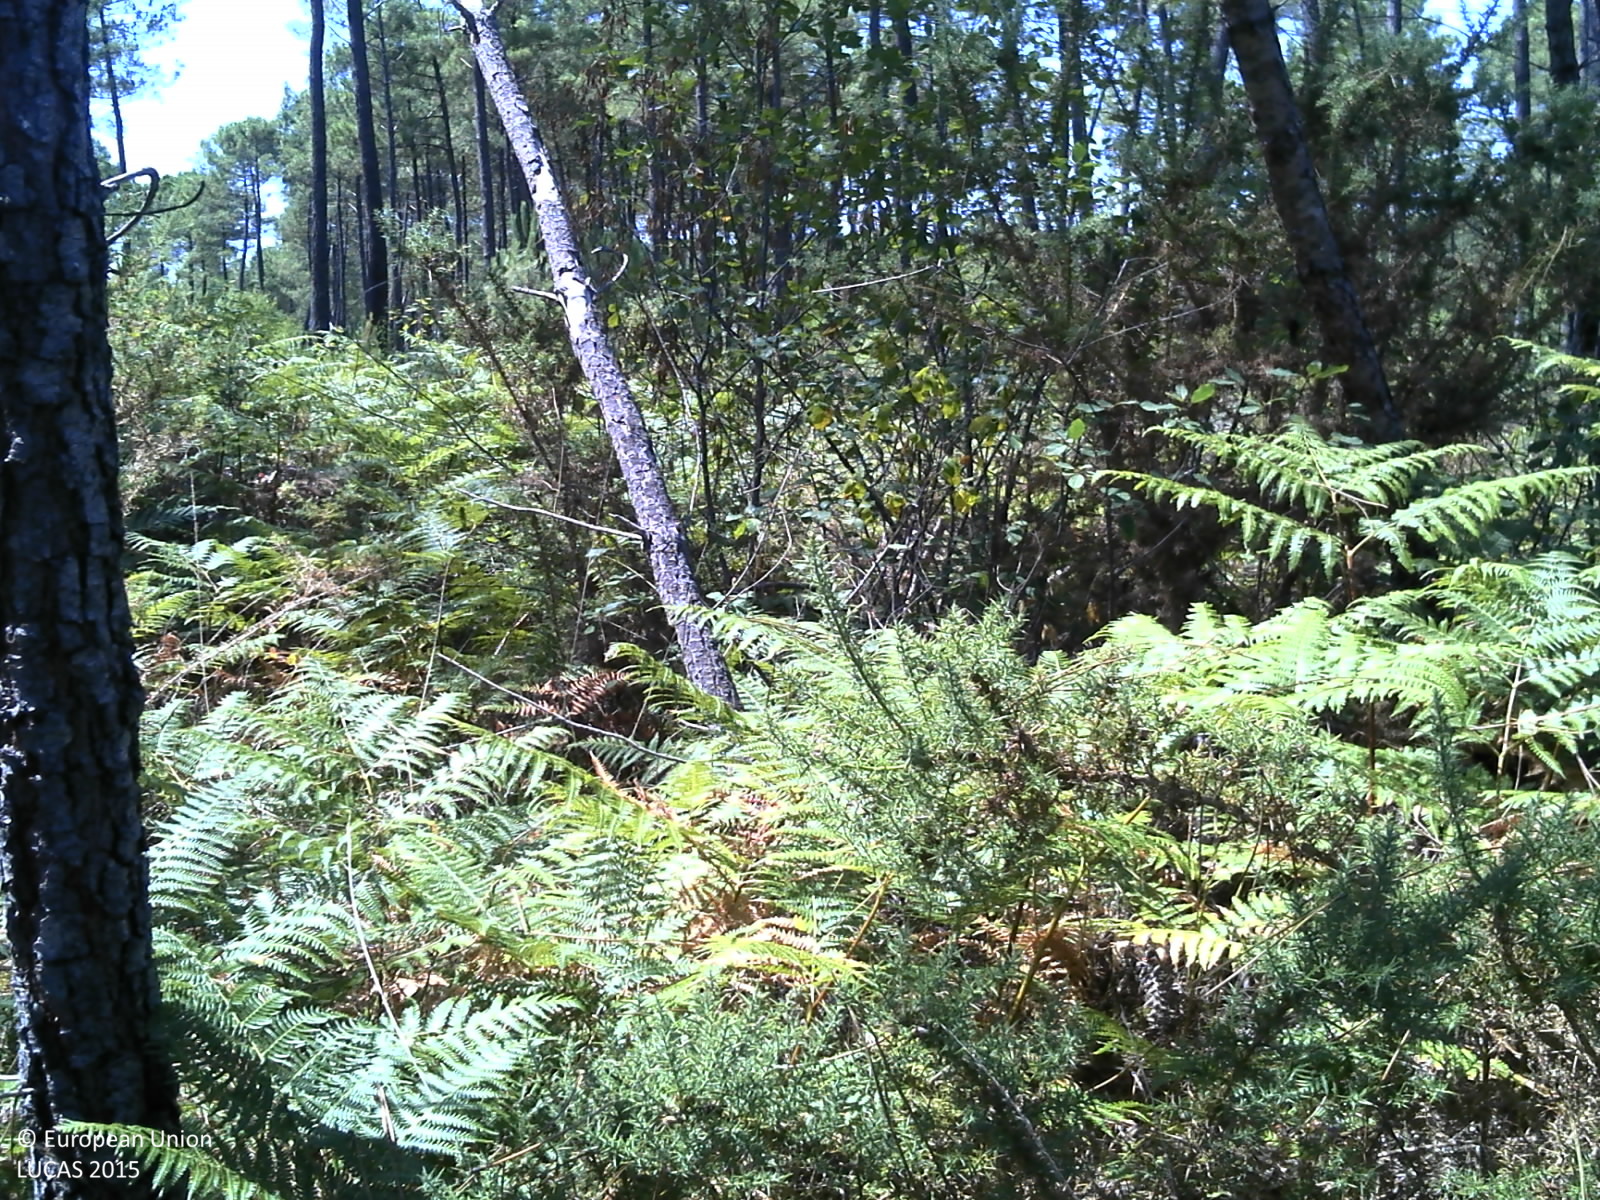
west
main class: Woodland
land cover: Pine dominated coniferous woodland
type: exotic forest
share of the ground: > 75 %
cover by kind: coniferous forest trees 60 %, shrubs 30 %, herbaceous plants 5 %, lichens and mosses 5 %
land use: Forestry
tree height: > 5 m
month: August
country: FR
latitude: 44.4822
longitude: -0.5651
